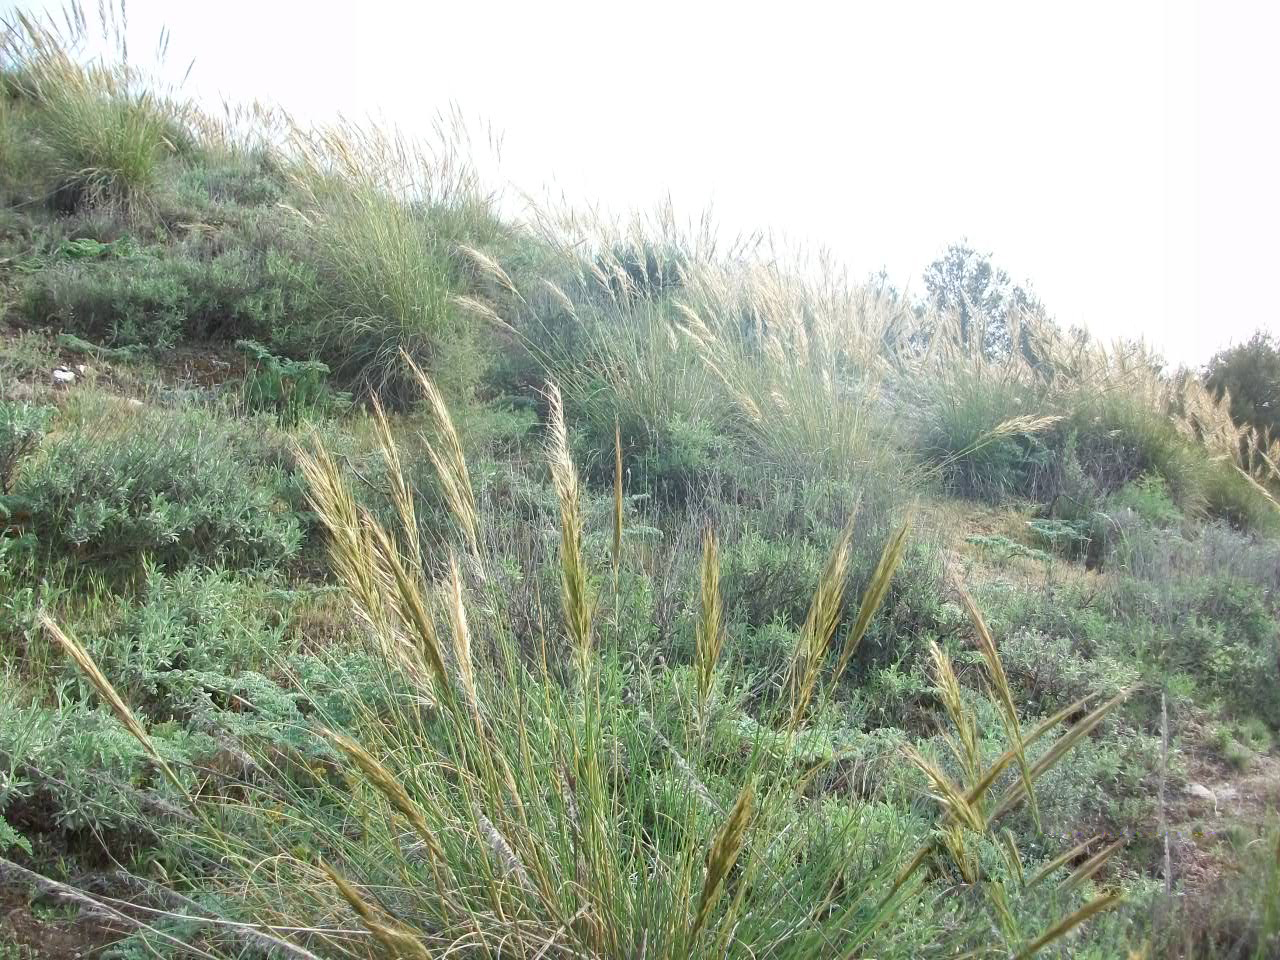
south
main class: Shrubland
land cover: Shrubland without tree cover
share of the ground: 25 - 50 %
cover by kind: shrubs 45 %, herbaceous plants 45 %, unconsolidated bare surface 10 %
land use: Semi-natural and natural areas not in use
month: May
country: ES
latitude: 40.0474
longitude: -3.7354
